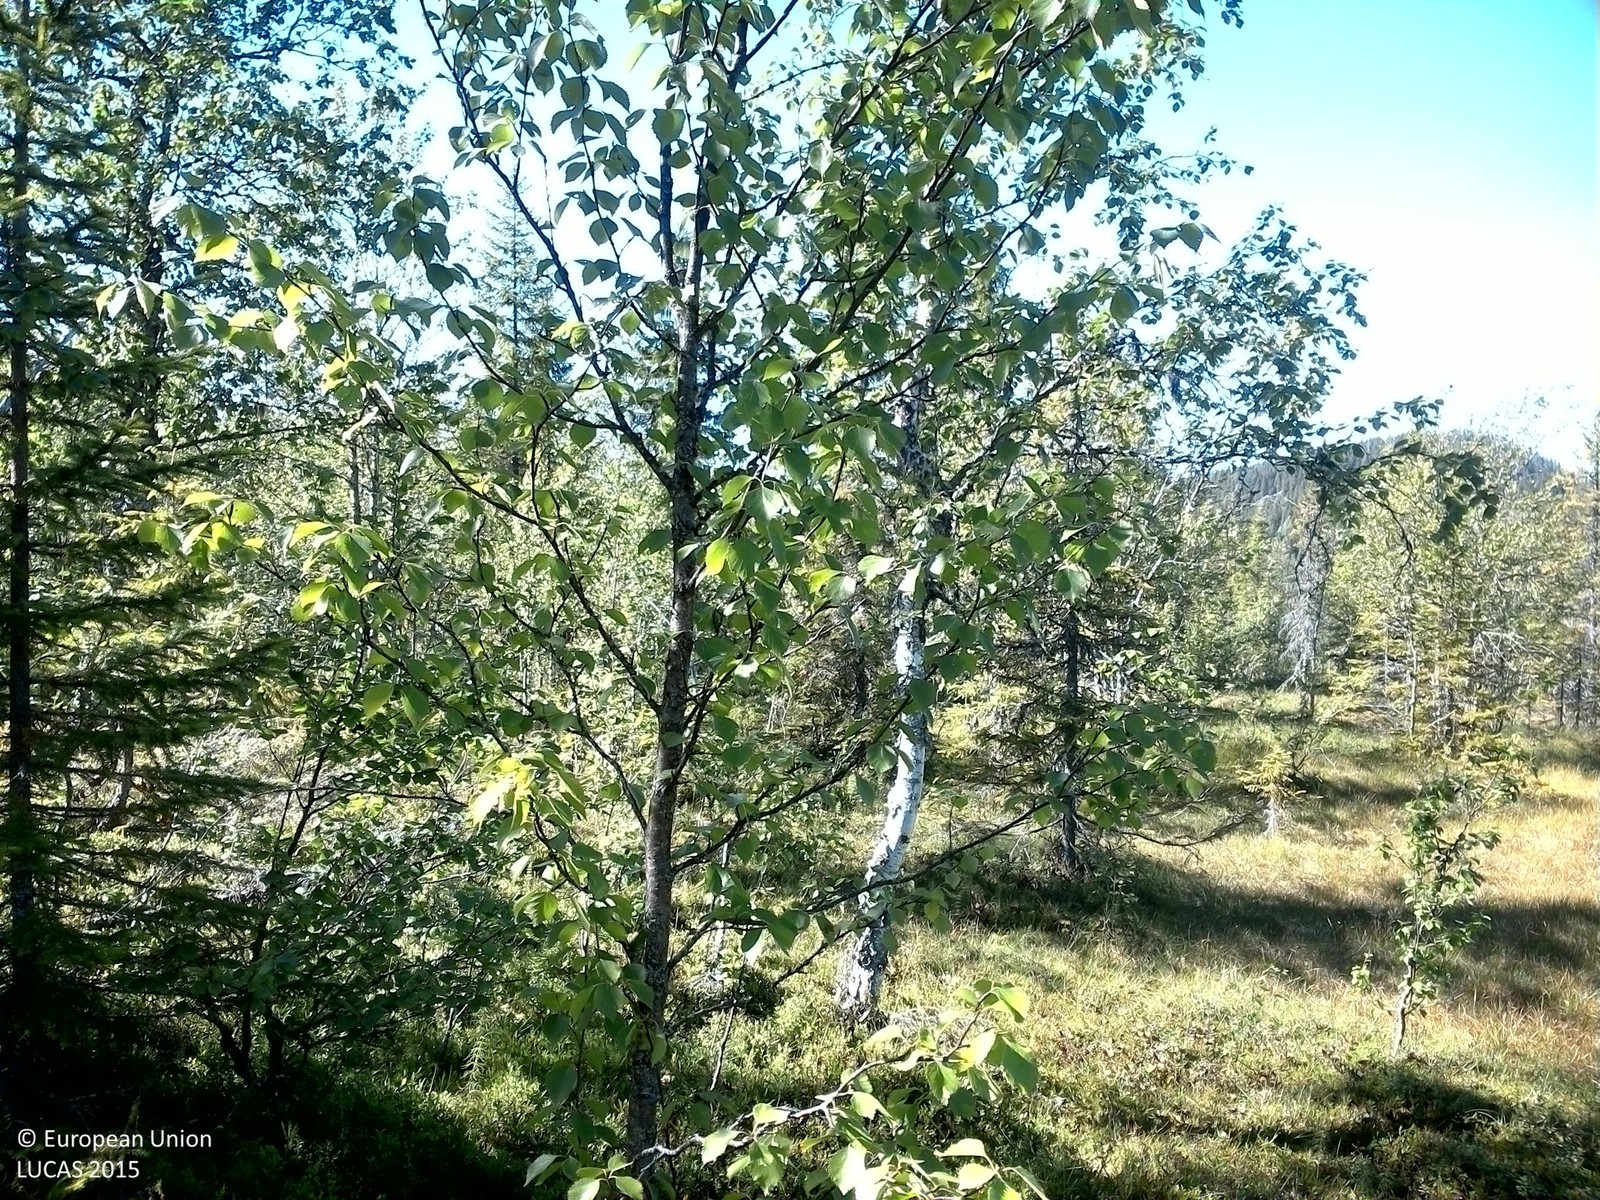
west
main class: Woodland
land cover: Broadleaved woodland
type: boreal forest
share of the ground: 25 - 50 %
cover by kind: shrubs 50 %, broadleaved forest trees 40 %, coniferous forest trees 5 %, lichens and mosses 5 %
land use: Forestry
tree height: < 5 m
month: August
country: SE
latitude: 63.8810
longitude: 17.7693
